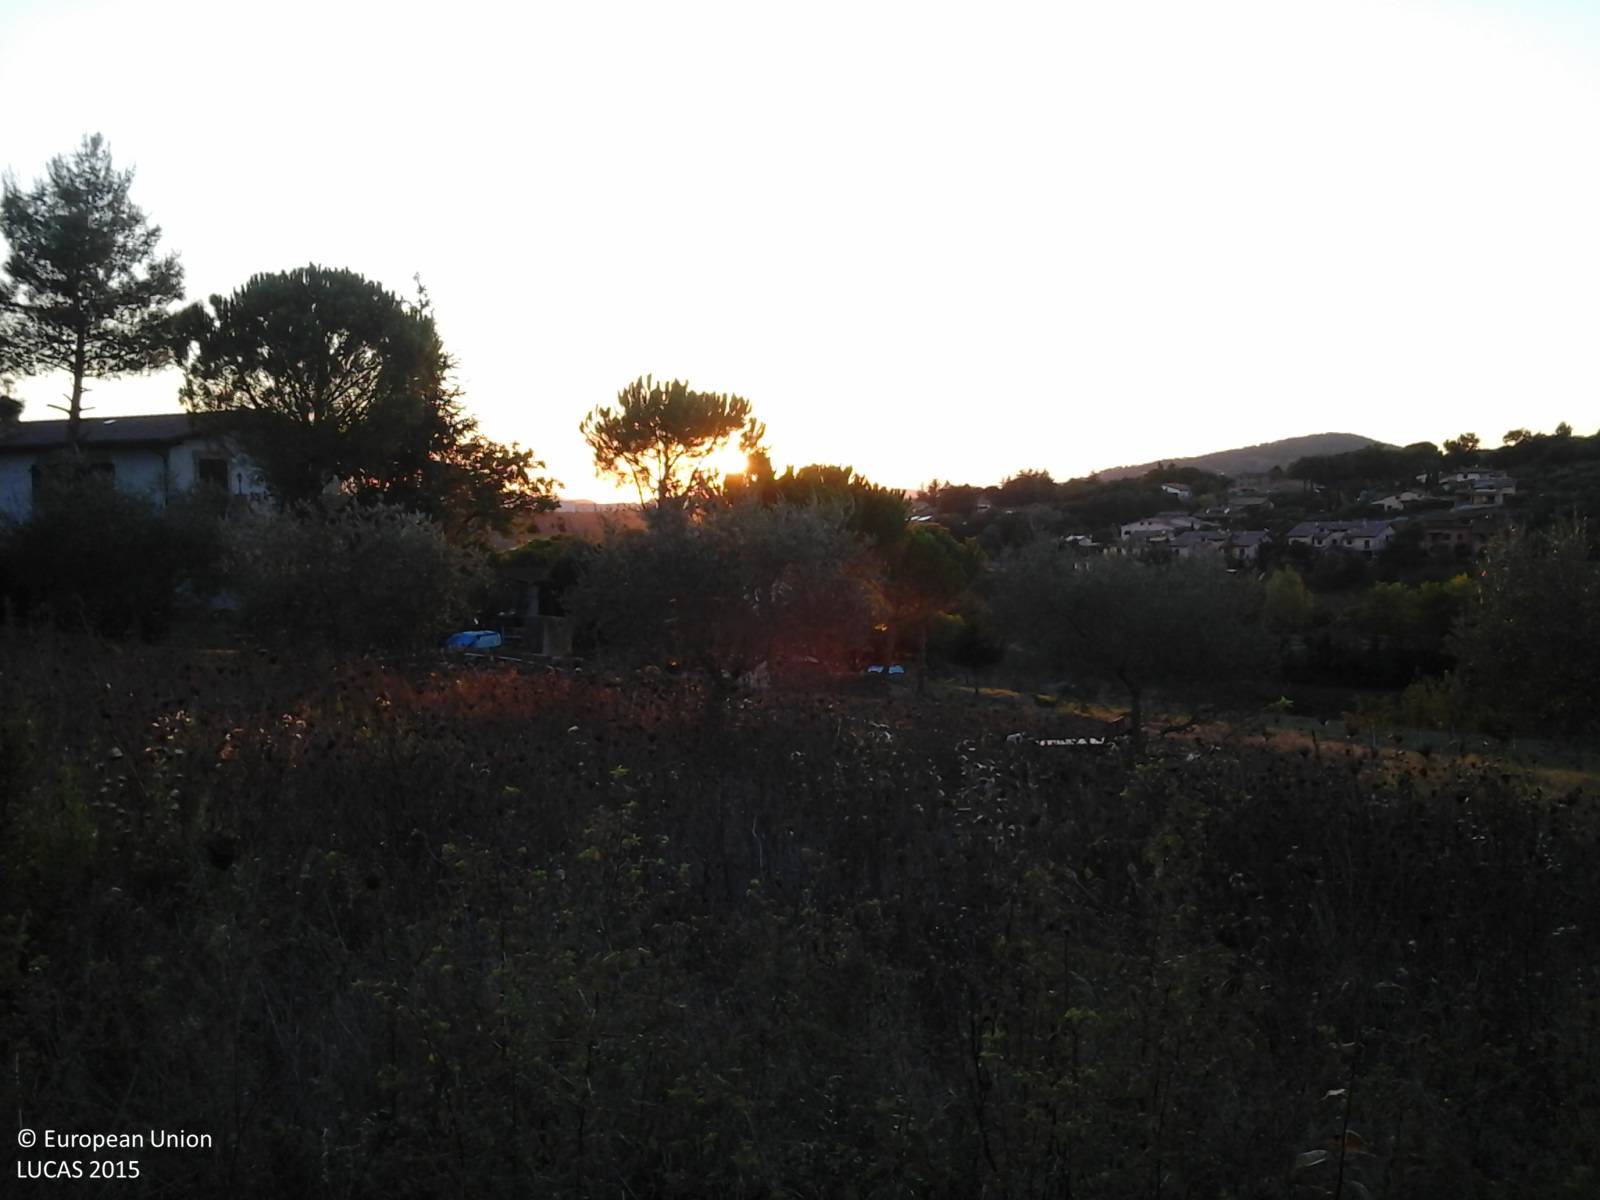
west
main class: Grassland
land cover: Spontaneously vegetated surfaces
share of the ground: > 75 %
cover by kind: herbaceous plants 100 %
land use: Abandoned areas
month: September
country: IT
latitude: 43.0775
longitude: 12.3881
